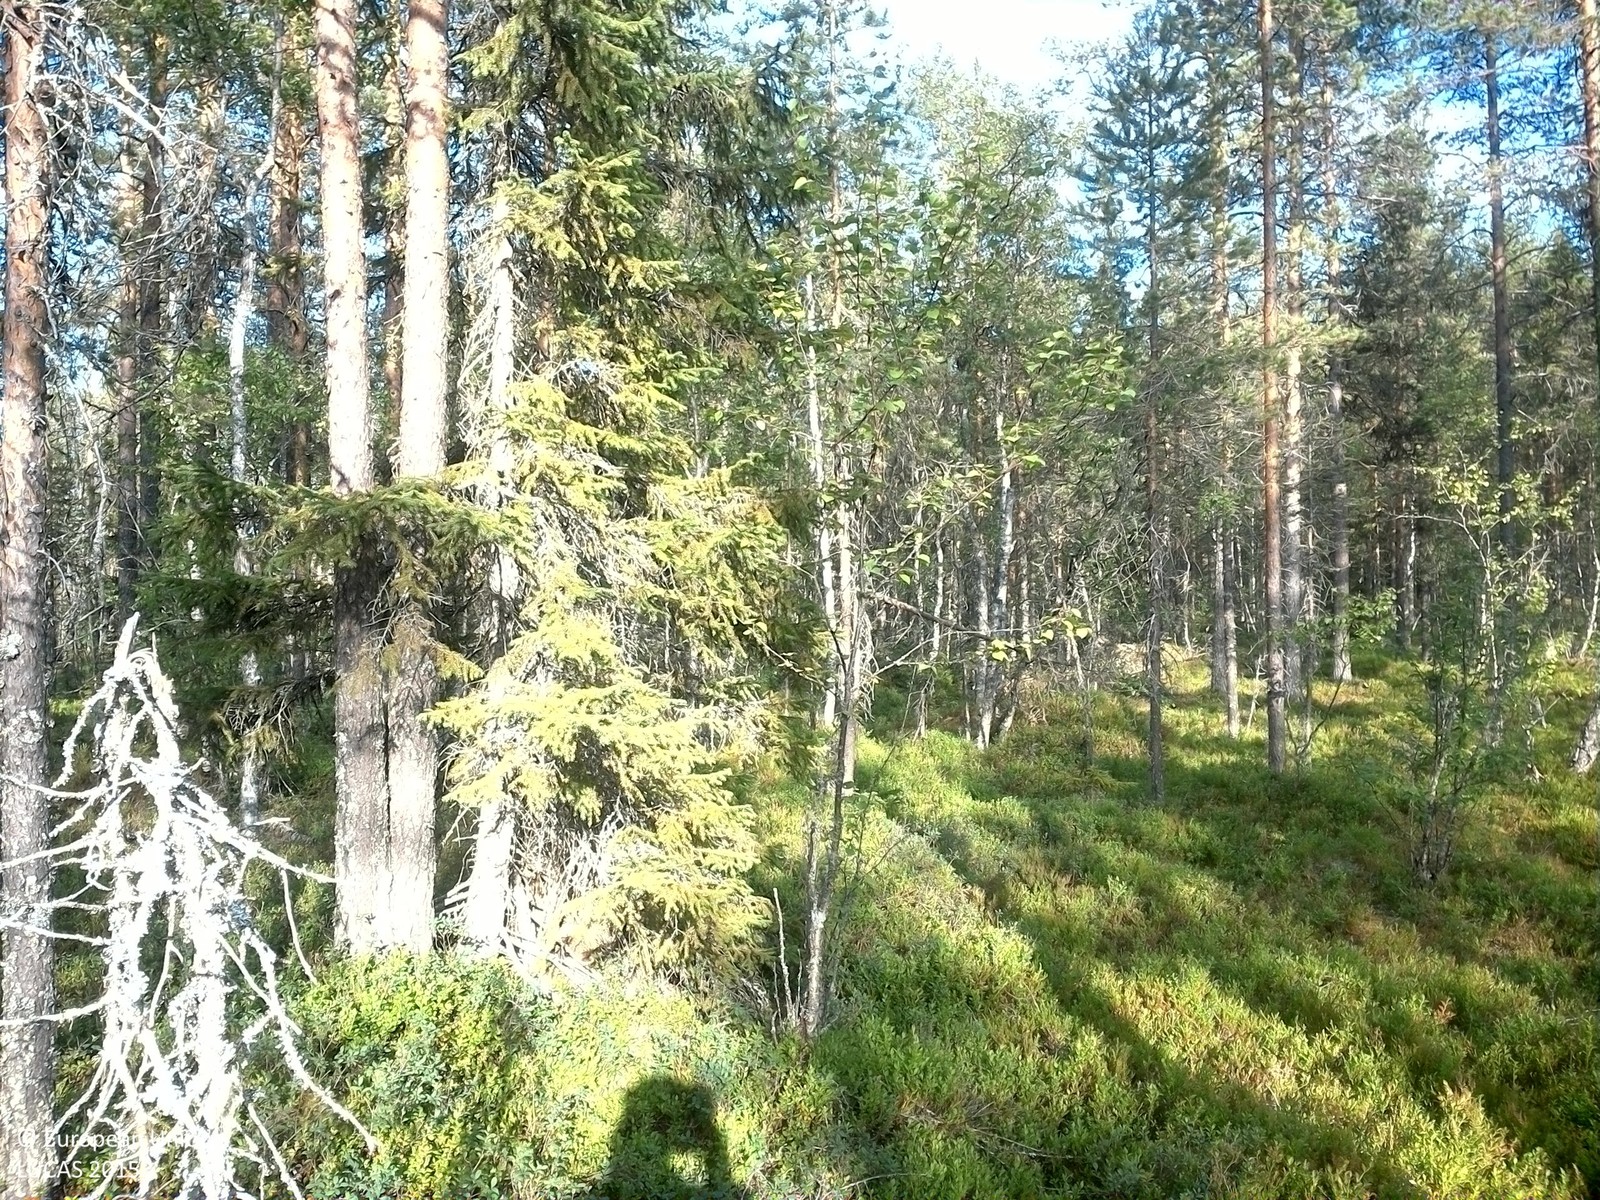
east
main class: Woodland
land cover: Pine dominated mixed woodland
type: boreal forest
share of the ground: 25 - 50 %
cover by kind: shrubs 40 %, coniferous forest trees 35 %, broadleaved forest trees 15 %, herbaceous plants 5 %, lichens and mosses 5 %
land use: Forestry
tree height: > 5 m
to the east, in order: Pine dominated mixed woodland; Pine dominated coniferous woodland; Ponds and wetlands; Pine dominated coniferous woodland; Inland marshes; Inland fresh running water
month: August
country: SE
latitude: 62.8503
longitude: 16.9508
